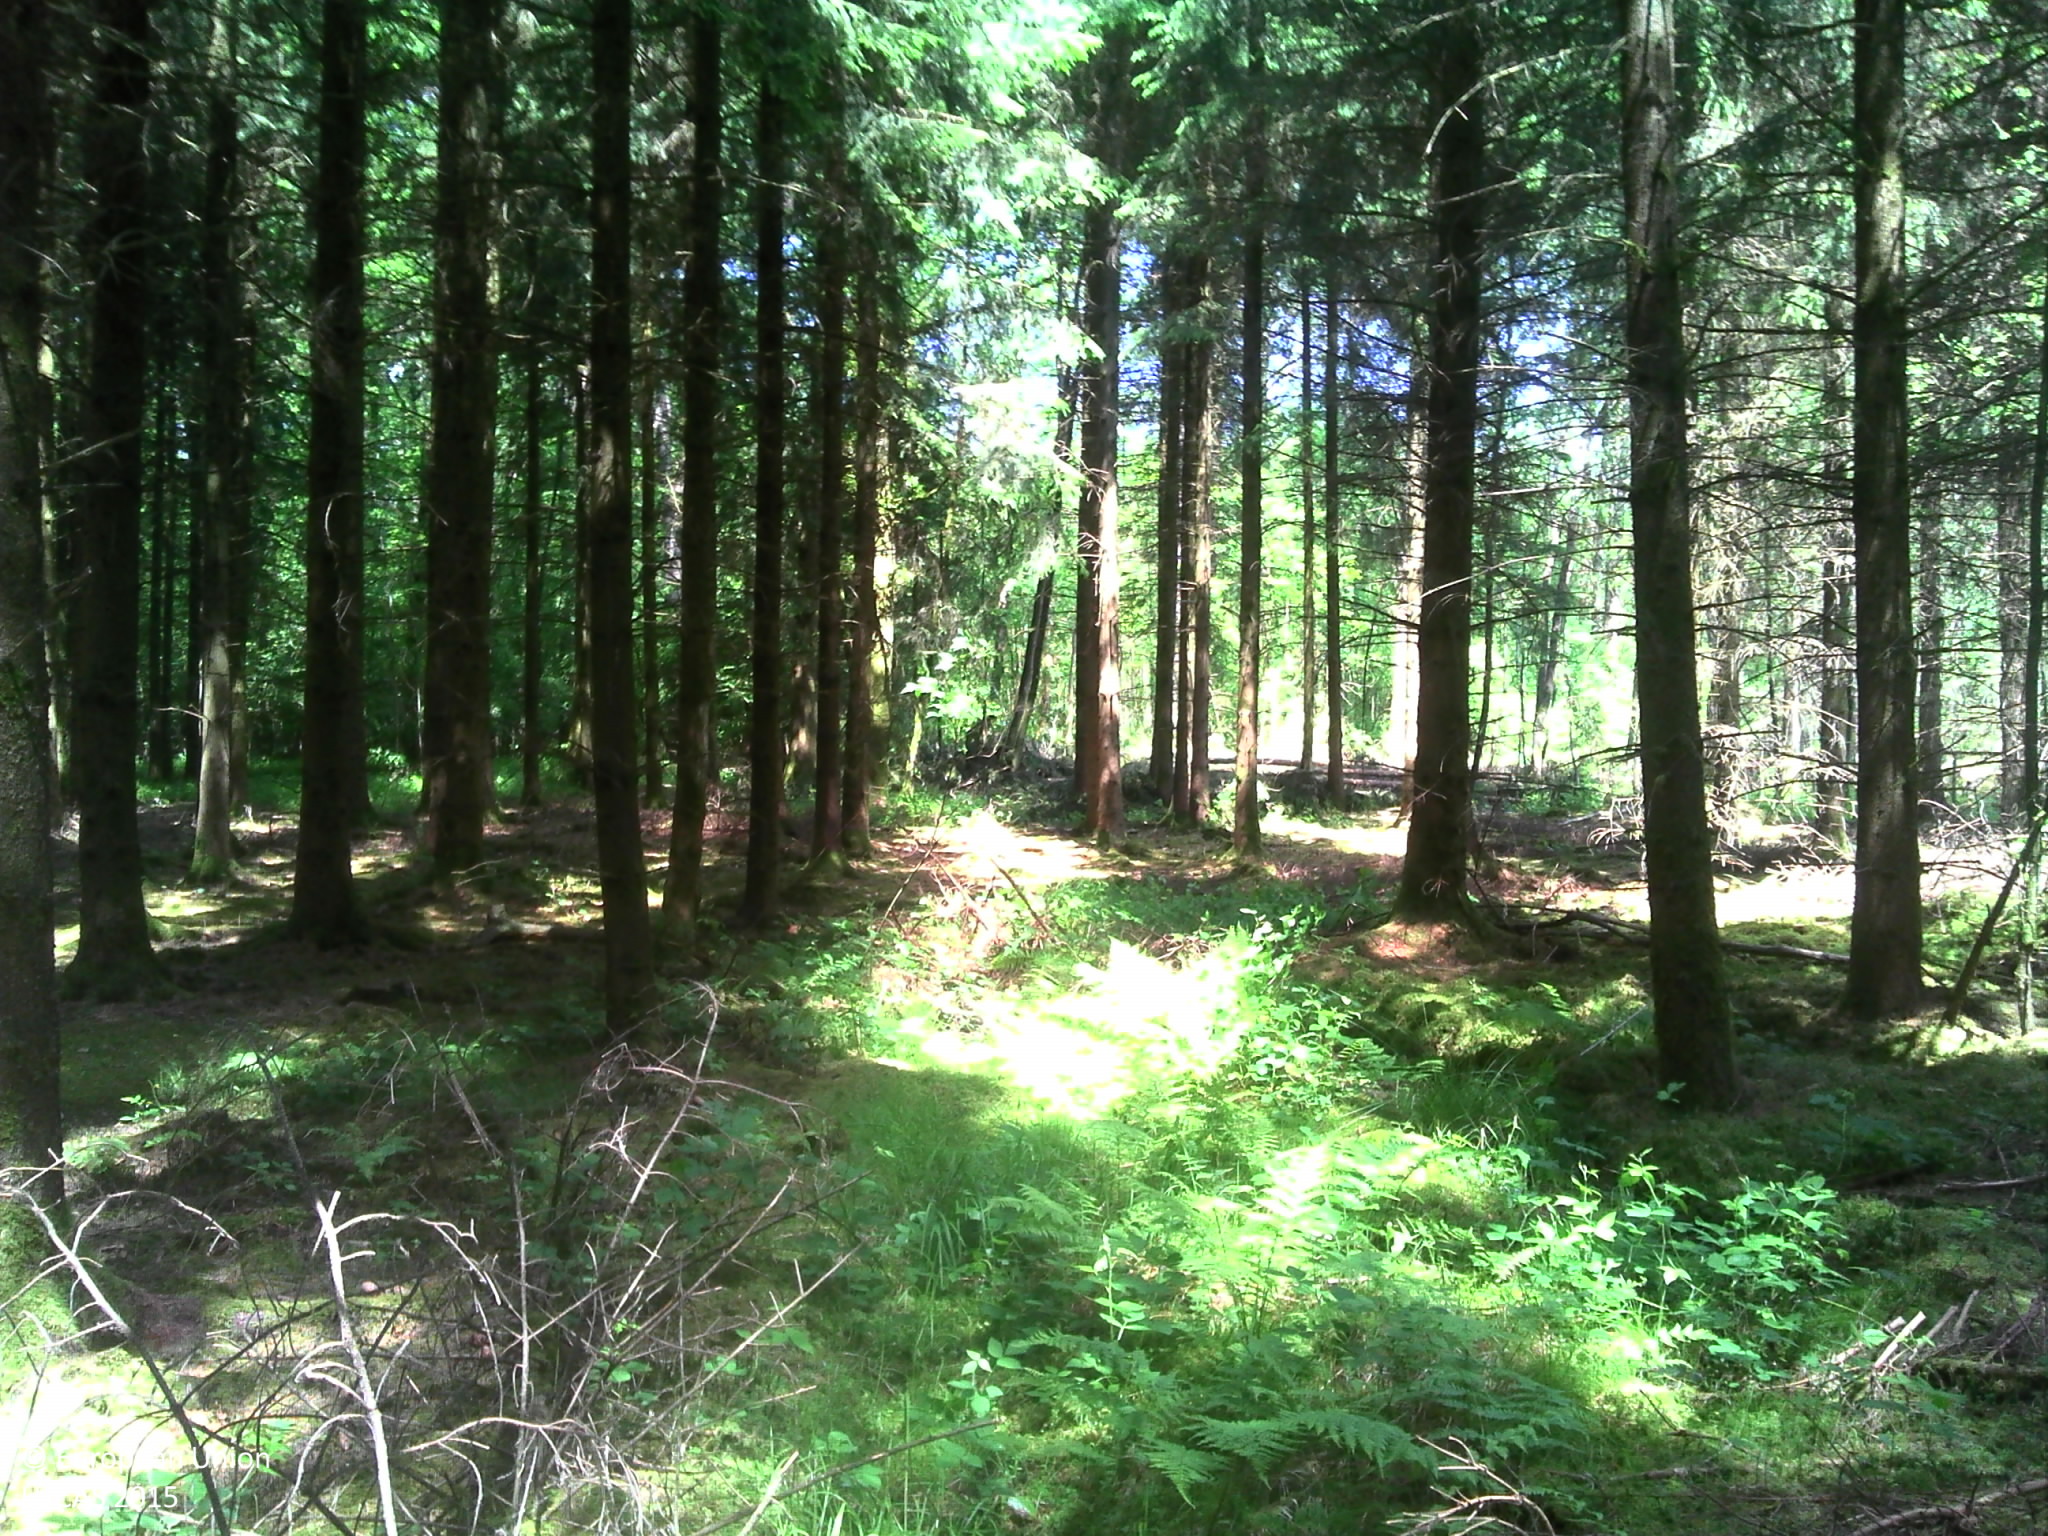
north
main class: Woodland
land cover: Spruce dominated coniferous woodland
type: exotic forest
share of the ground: > 75 %
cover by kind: coniferous forest trees 90 %, herbaceous plants 5 %, lichens and mosses 5 %
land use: Forestry
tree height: > 5 m
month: June
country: BE
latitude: 49.9596
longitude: 4.4620
